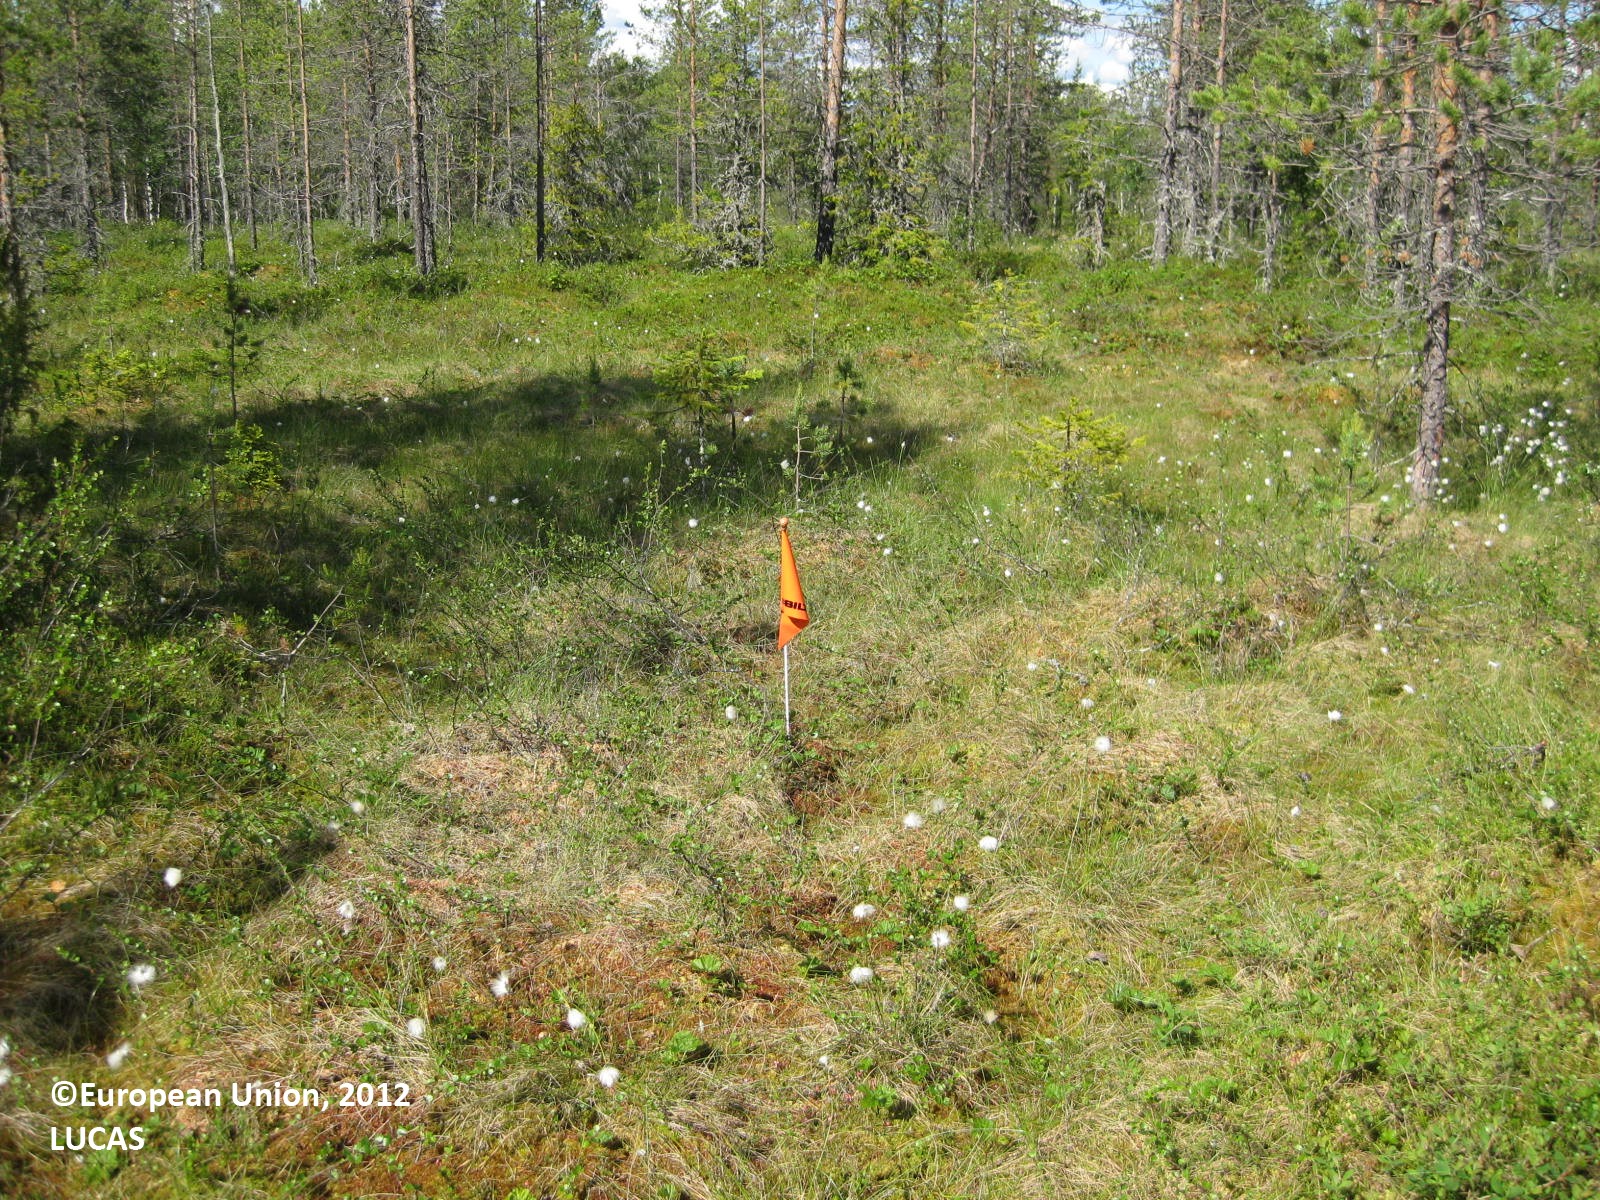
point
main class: Woodland
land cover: Pine dominated coniferous woodland
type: boreal forest
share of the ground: 50 - 75 %
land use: Forestry
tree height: > 5 m
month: July
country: FI
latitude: 65.6085
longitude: 29.4886
